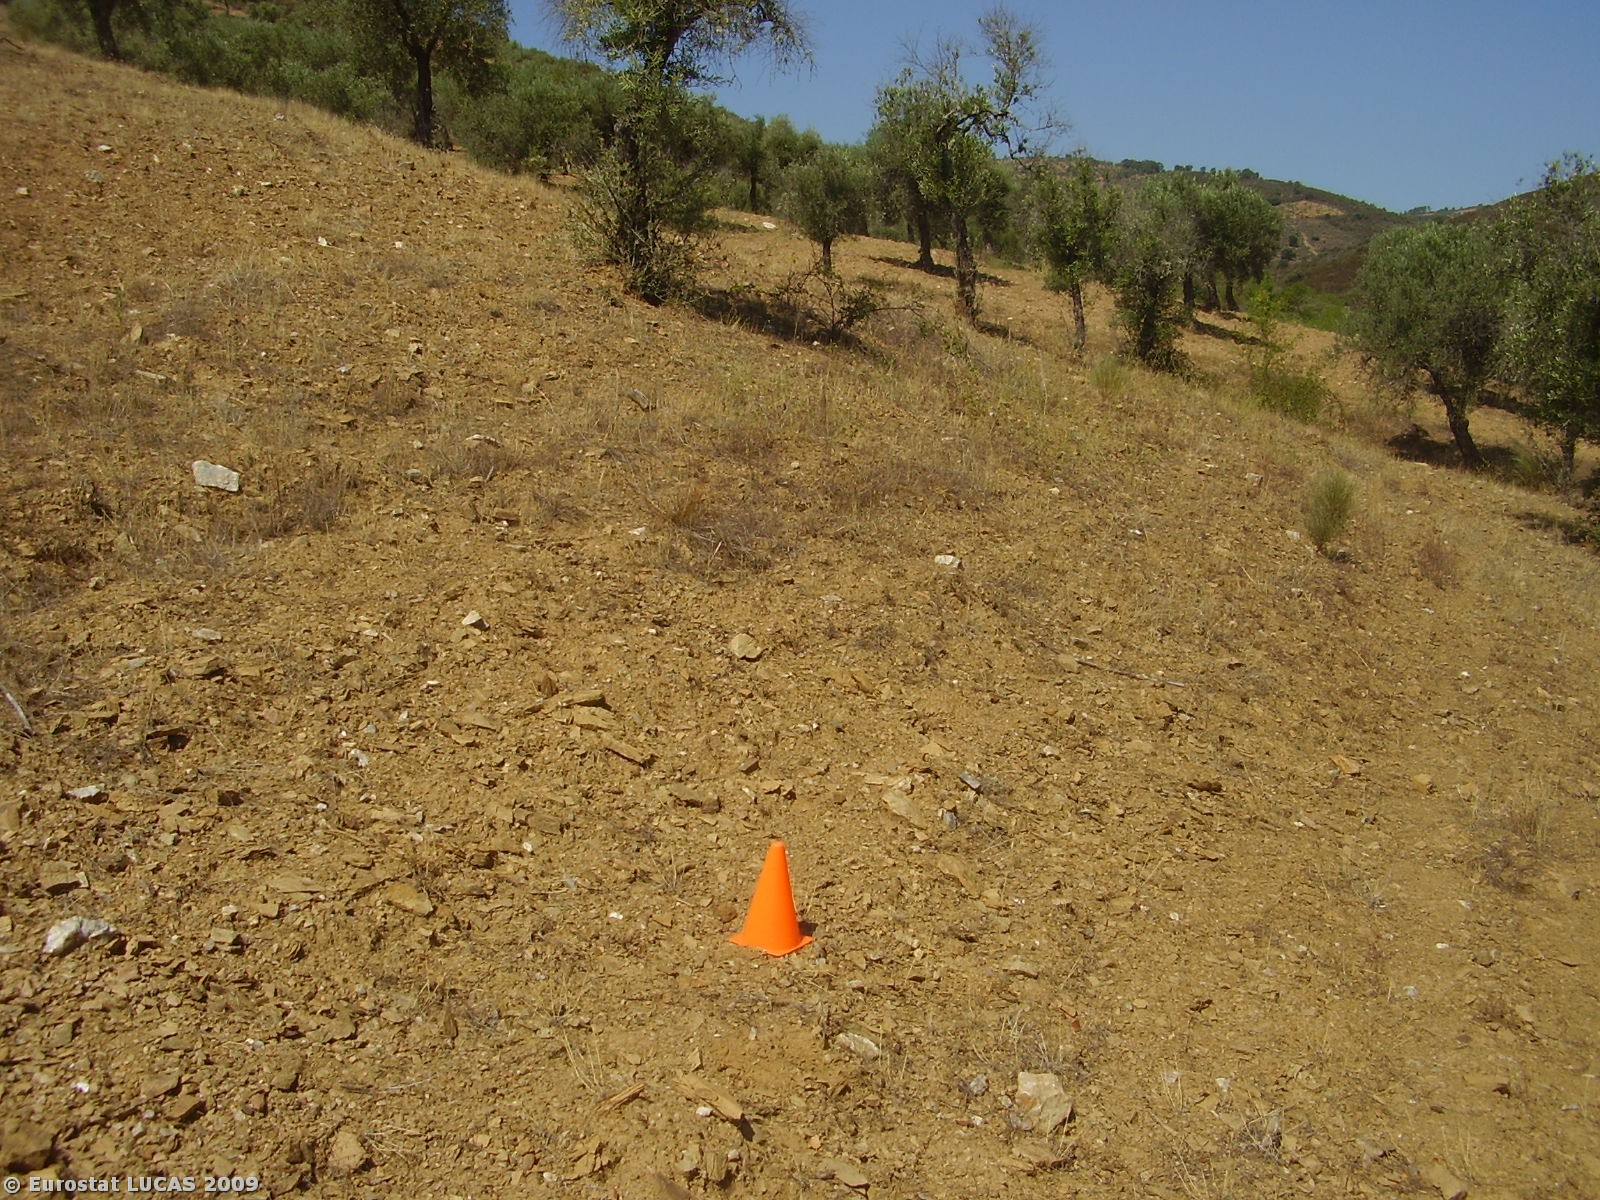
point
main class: Cropland
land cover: Olive groves
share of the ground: 10 - 25 %
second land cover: Spontaneously vegetated surfaces
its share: < 10 %
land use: Agriculture (excluding fallow land and kitchen gardens)
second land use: Fallow land
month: August
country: PT
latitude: 41.4366
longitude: -6.8285
